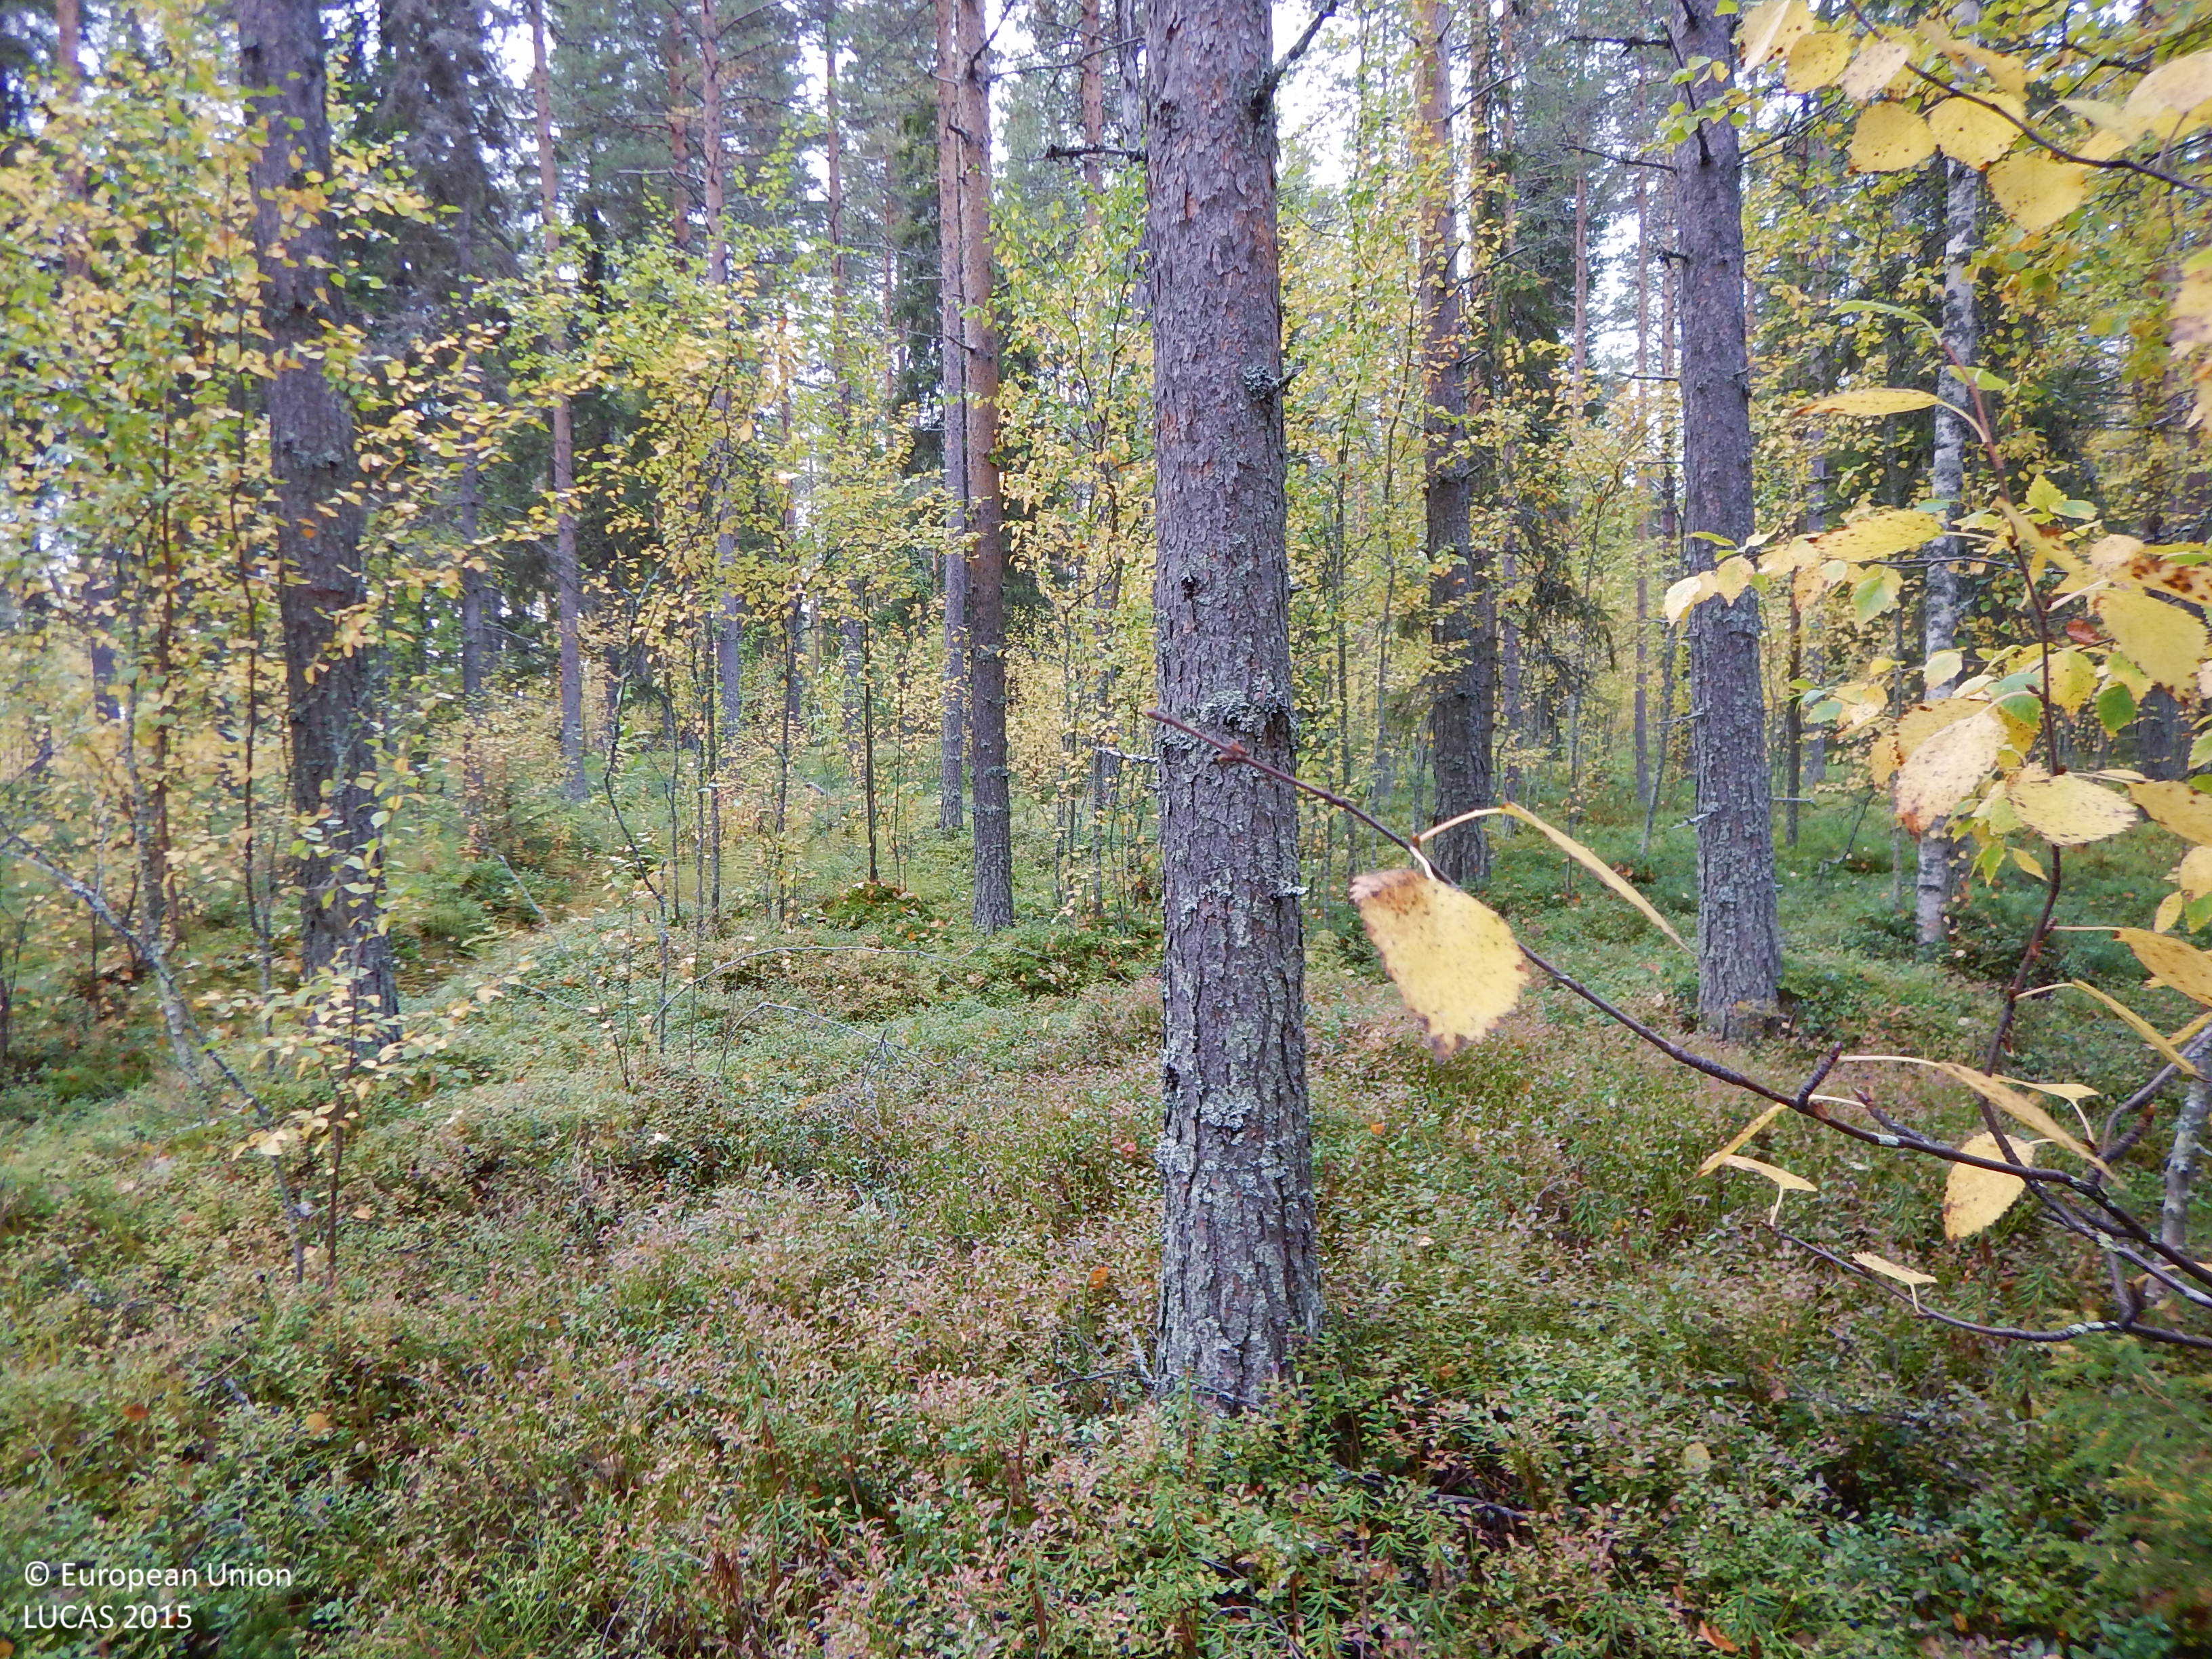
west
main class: Woodland
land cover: Pine dominated mixed woodland
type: boreal forest
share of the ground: 50 - 75 %
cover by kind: coniferous forest trees 40 %, shrubs 20 %, broadleaved forest trees 15 %, lichens and mosses 15 %, herbaceous plants 10 %
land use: Forestry
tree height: > 5 m
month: September
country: SE
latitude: 64.8384
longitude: 19.8564
